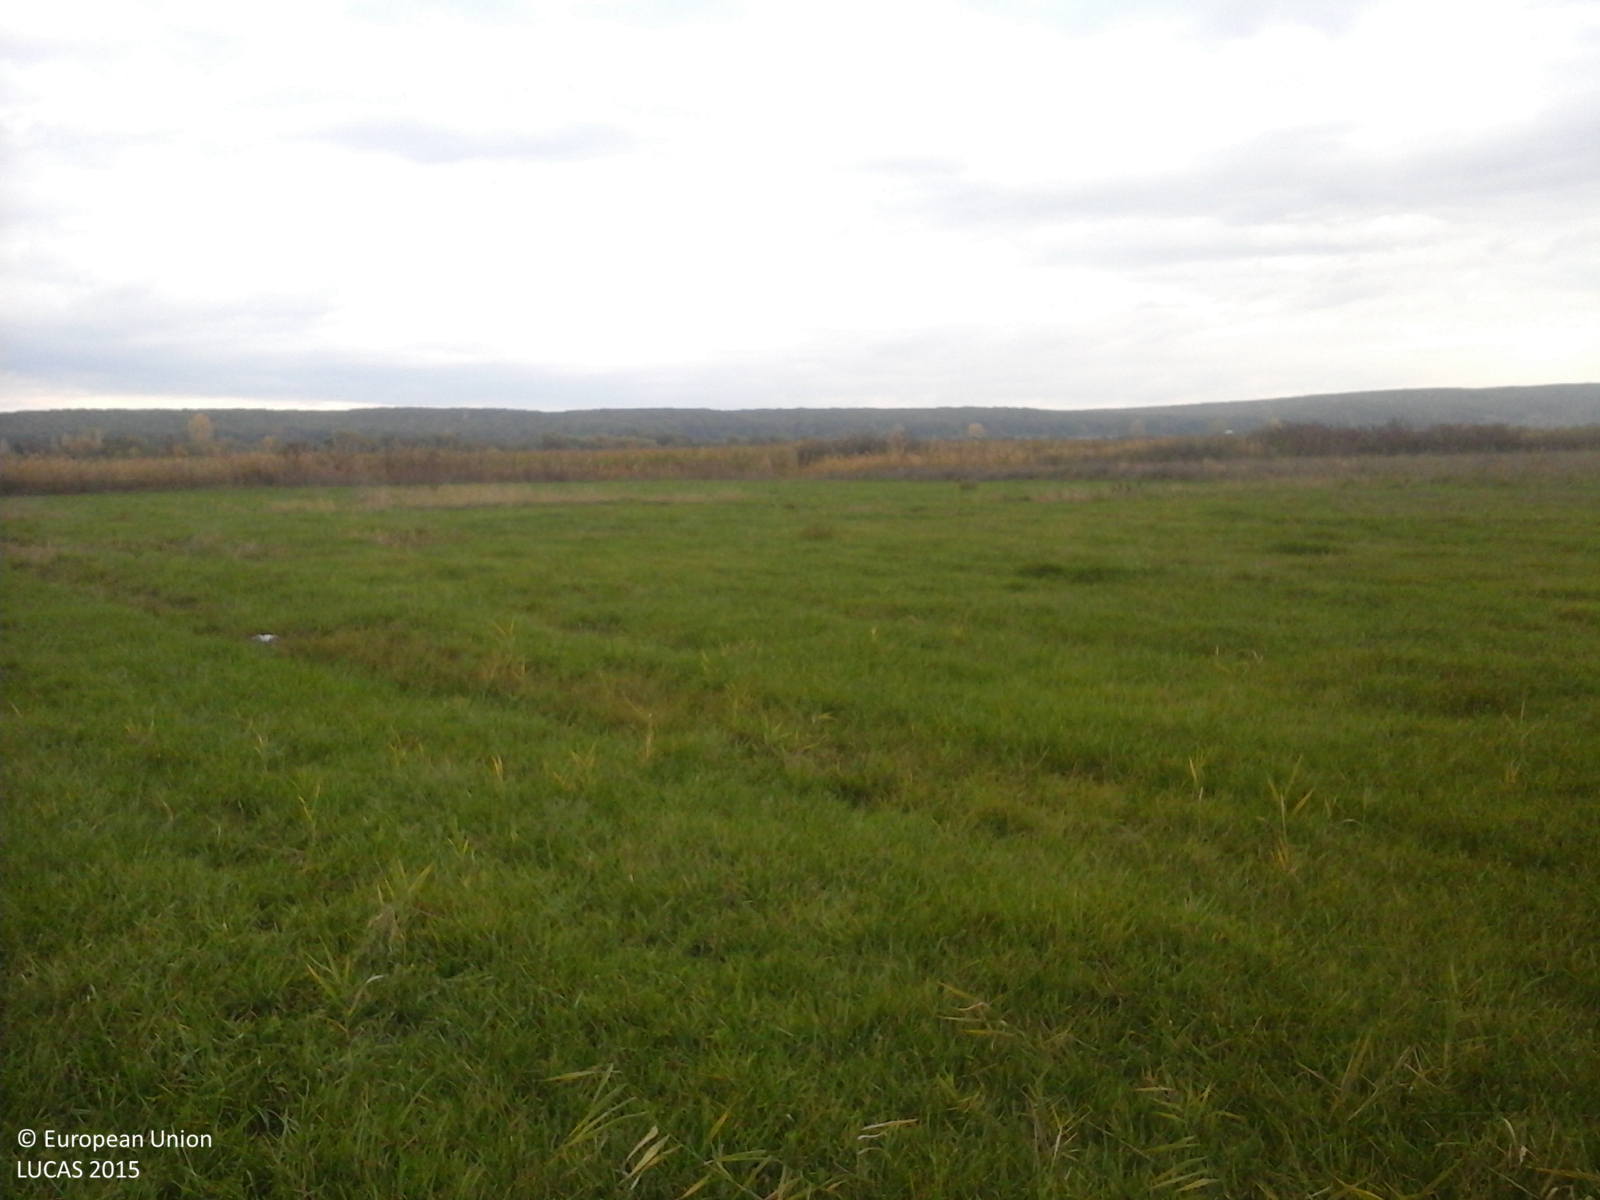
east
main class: Grassland
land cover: Grassland without tree/shrub cover
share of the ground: > 75 %
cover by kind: herbaceous plants 100 %
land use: Agriculture (excluding fallow land and kitchen gardens)
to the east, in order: Grassland without tree/shrub cover; Tracks; Grass margins; Ditches and canals; Maize
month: October
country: RO
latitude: 44.9025
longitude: 25.6121
